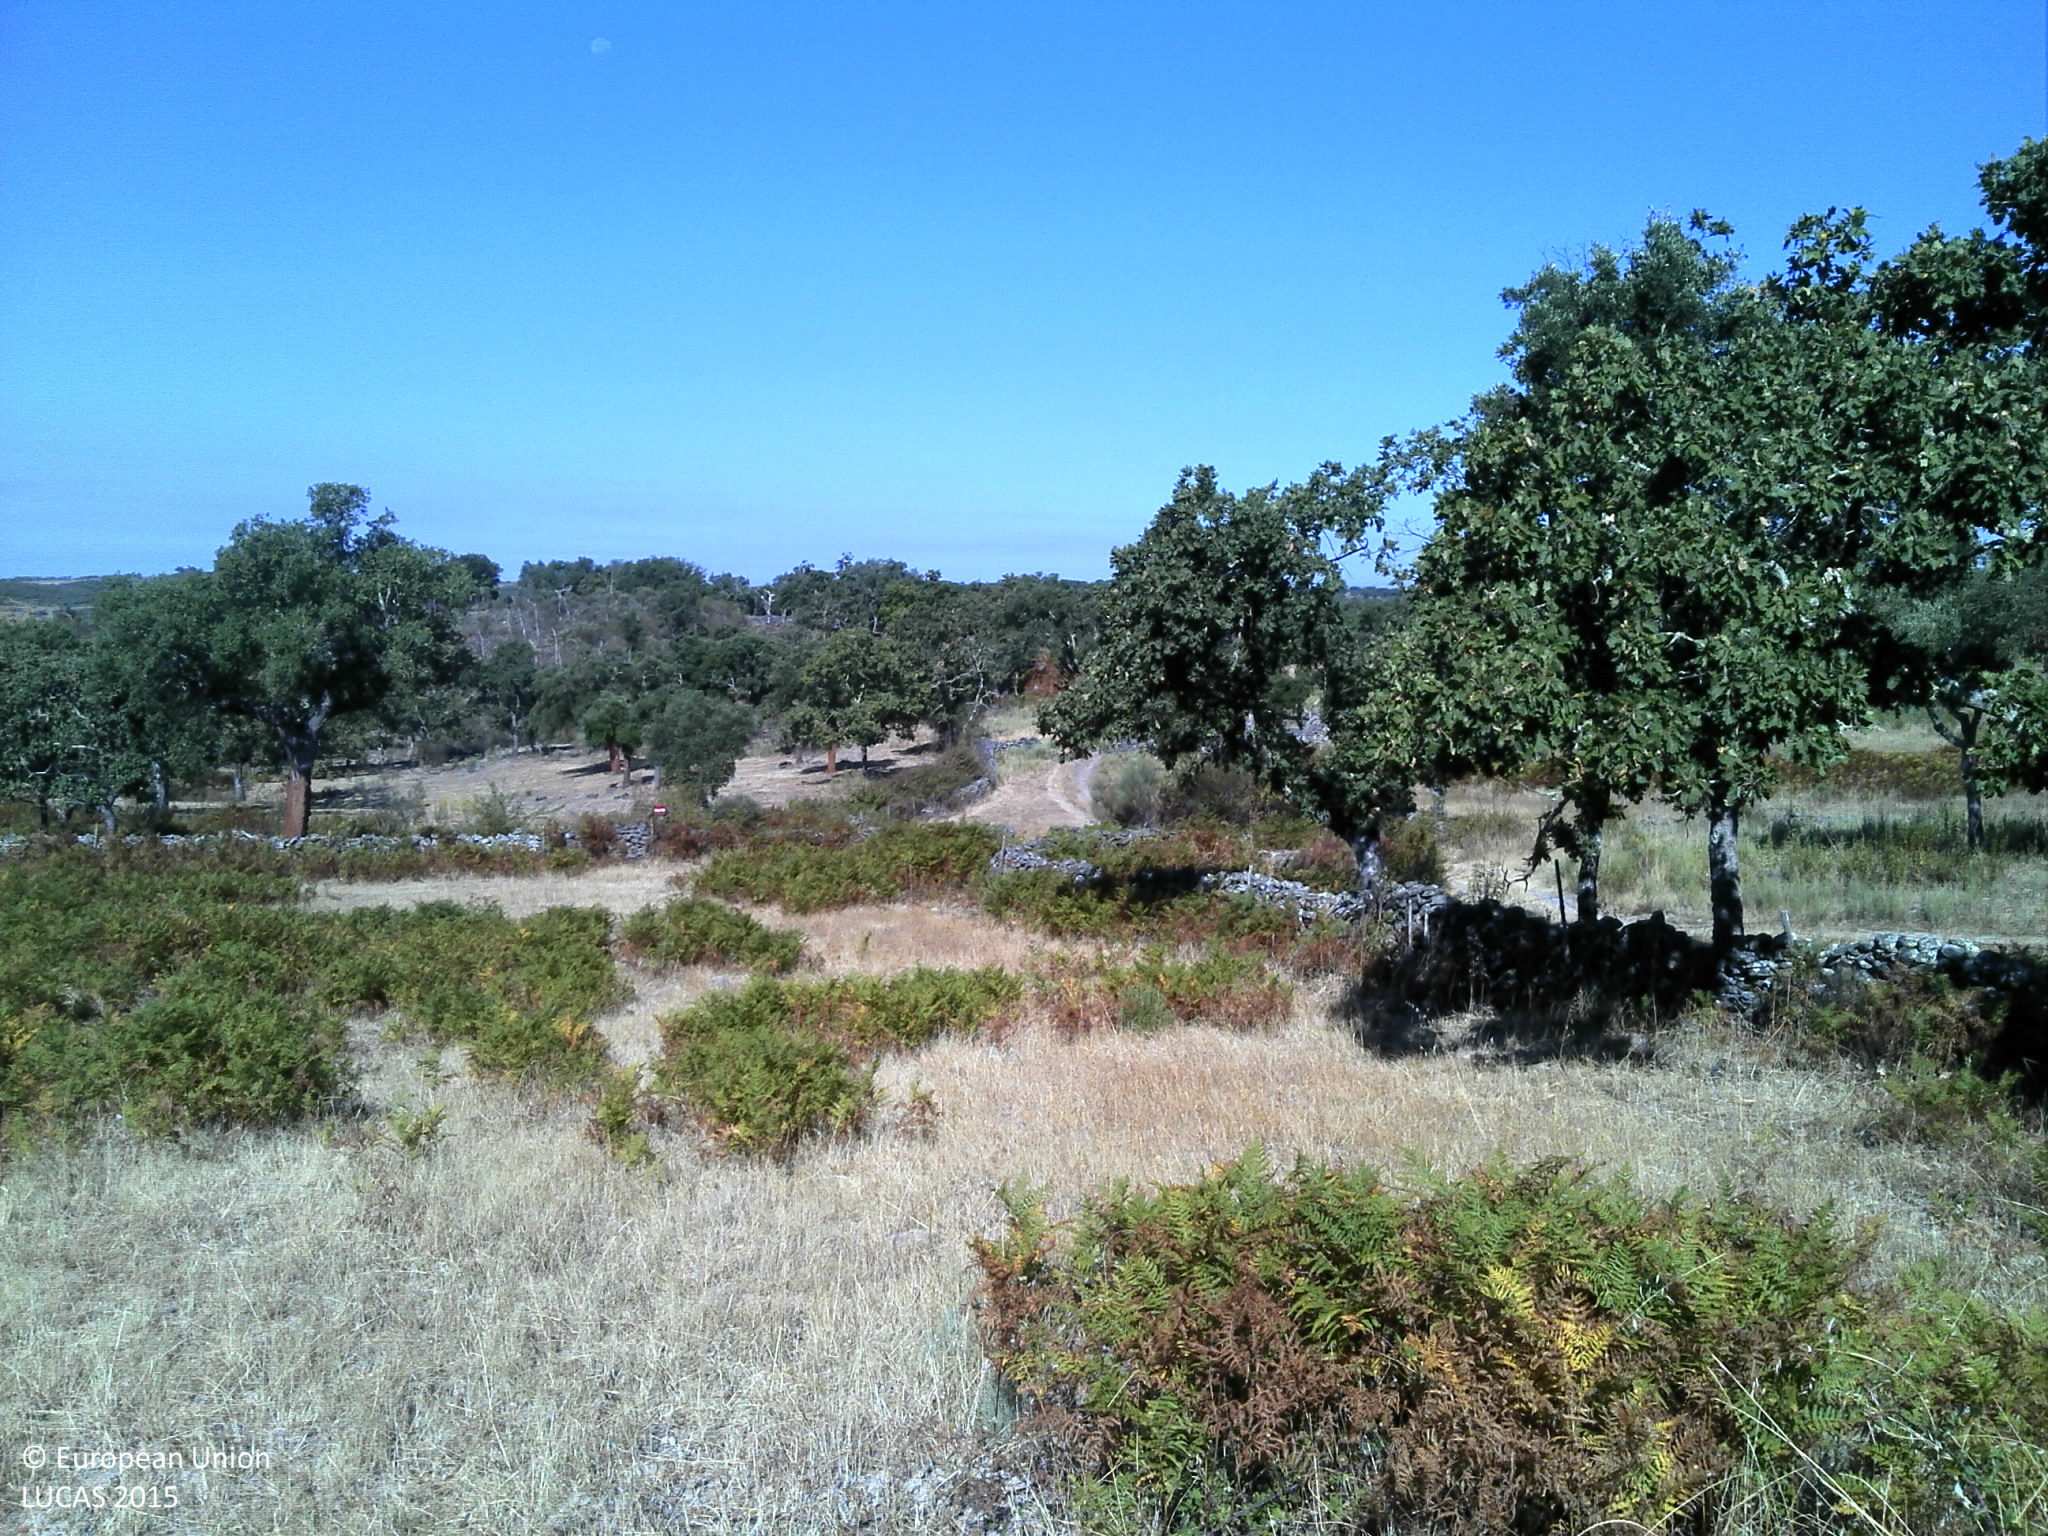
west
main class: Woodland
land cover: Broadleaved woodland
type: broadleaved evergreen forest
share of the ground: 10 - 25 %
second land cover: Grassland without tree/shrub cover
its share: 50 - 75 %
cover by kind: herbaceous plants 60 %, broadleaved forest trees 15 %, unconsolidated bare surface 15 %, consolidated bare surface 10 %
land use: Forestry
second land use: Agriculture (excluding fallow land and kitchen gardens)
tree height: > 5 m
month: August
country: PT
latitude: 39.3833
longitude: -7.4937
